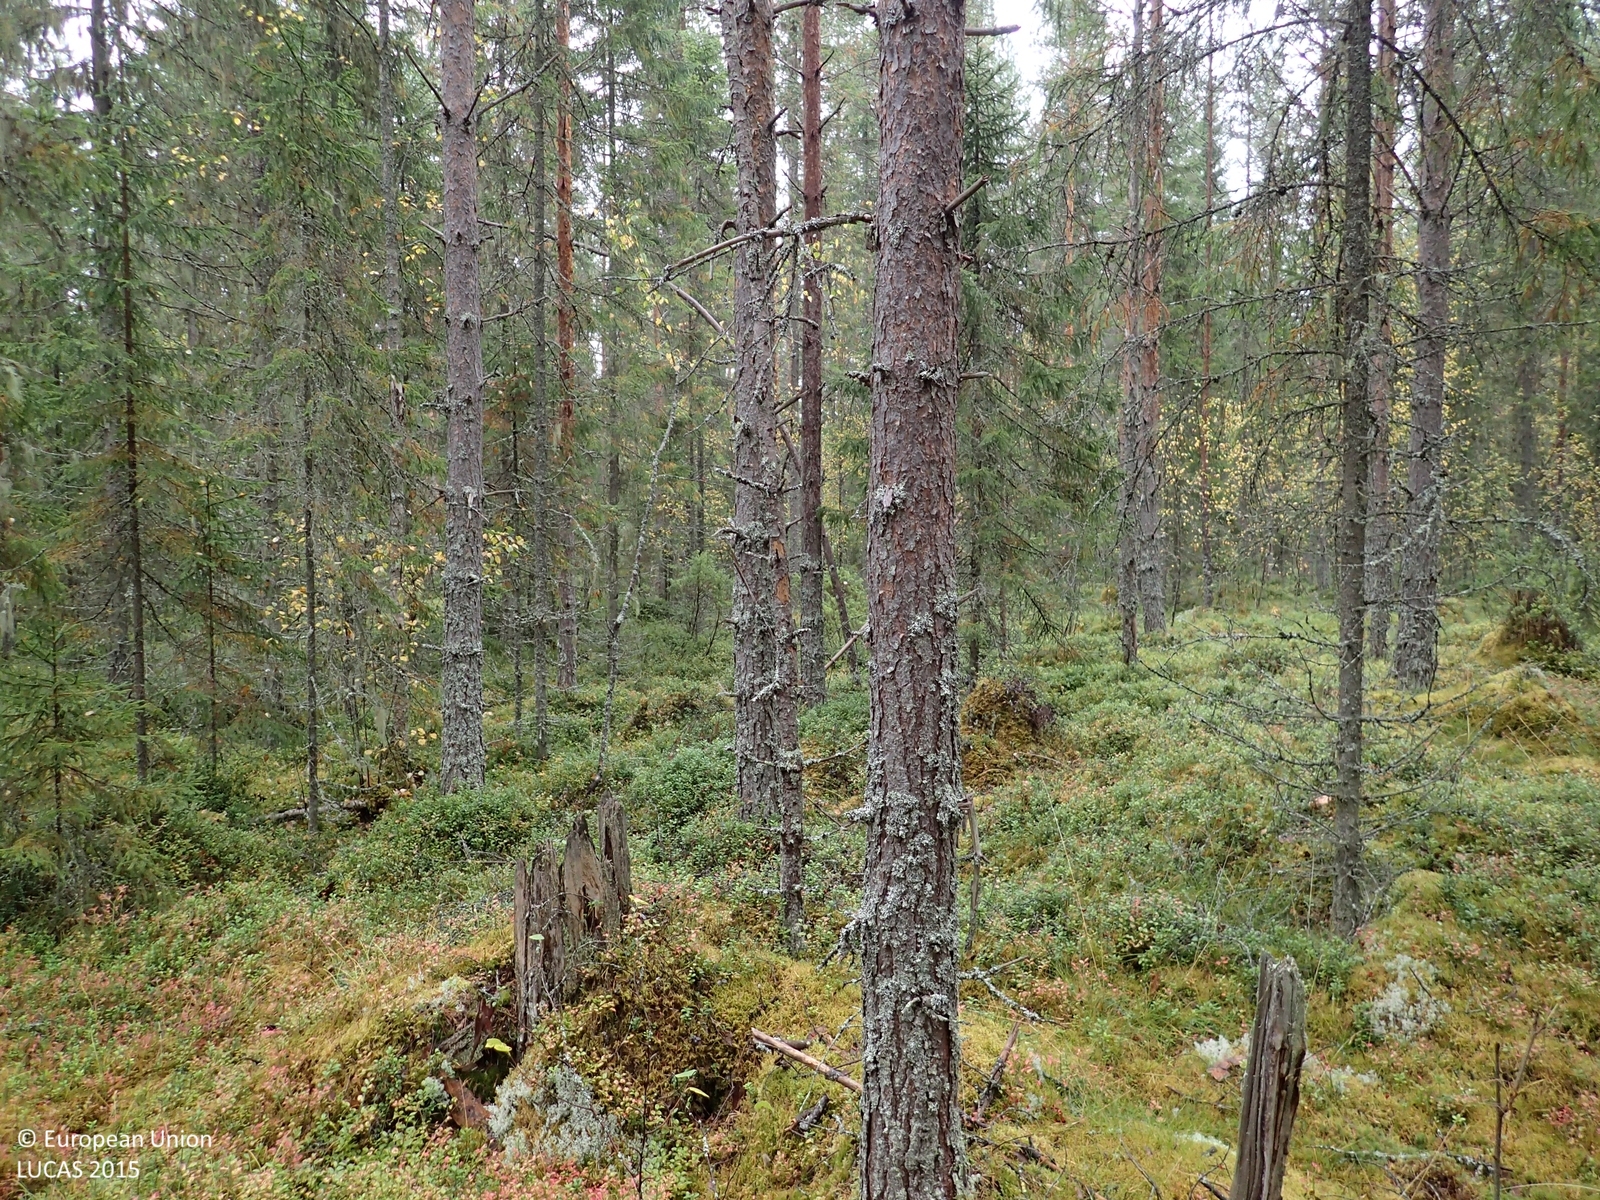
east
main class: Woodland
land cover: Other coniferous woodland
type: boreal forest
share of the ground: > 75 %
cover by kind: coniferous forest trees 70 %, shrubs 20 %, broadleaved forest trees 5 %, lichens and mosses 5 %
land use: Forestry
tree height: > 5 m
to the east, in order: Other coniferous woodland; Ditches and canals; Other coniferous woodland; Spruce dominated coniferous woodland
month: September
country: FI
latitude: 63.2616
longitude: 25.6670
